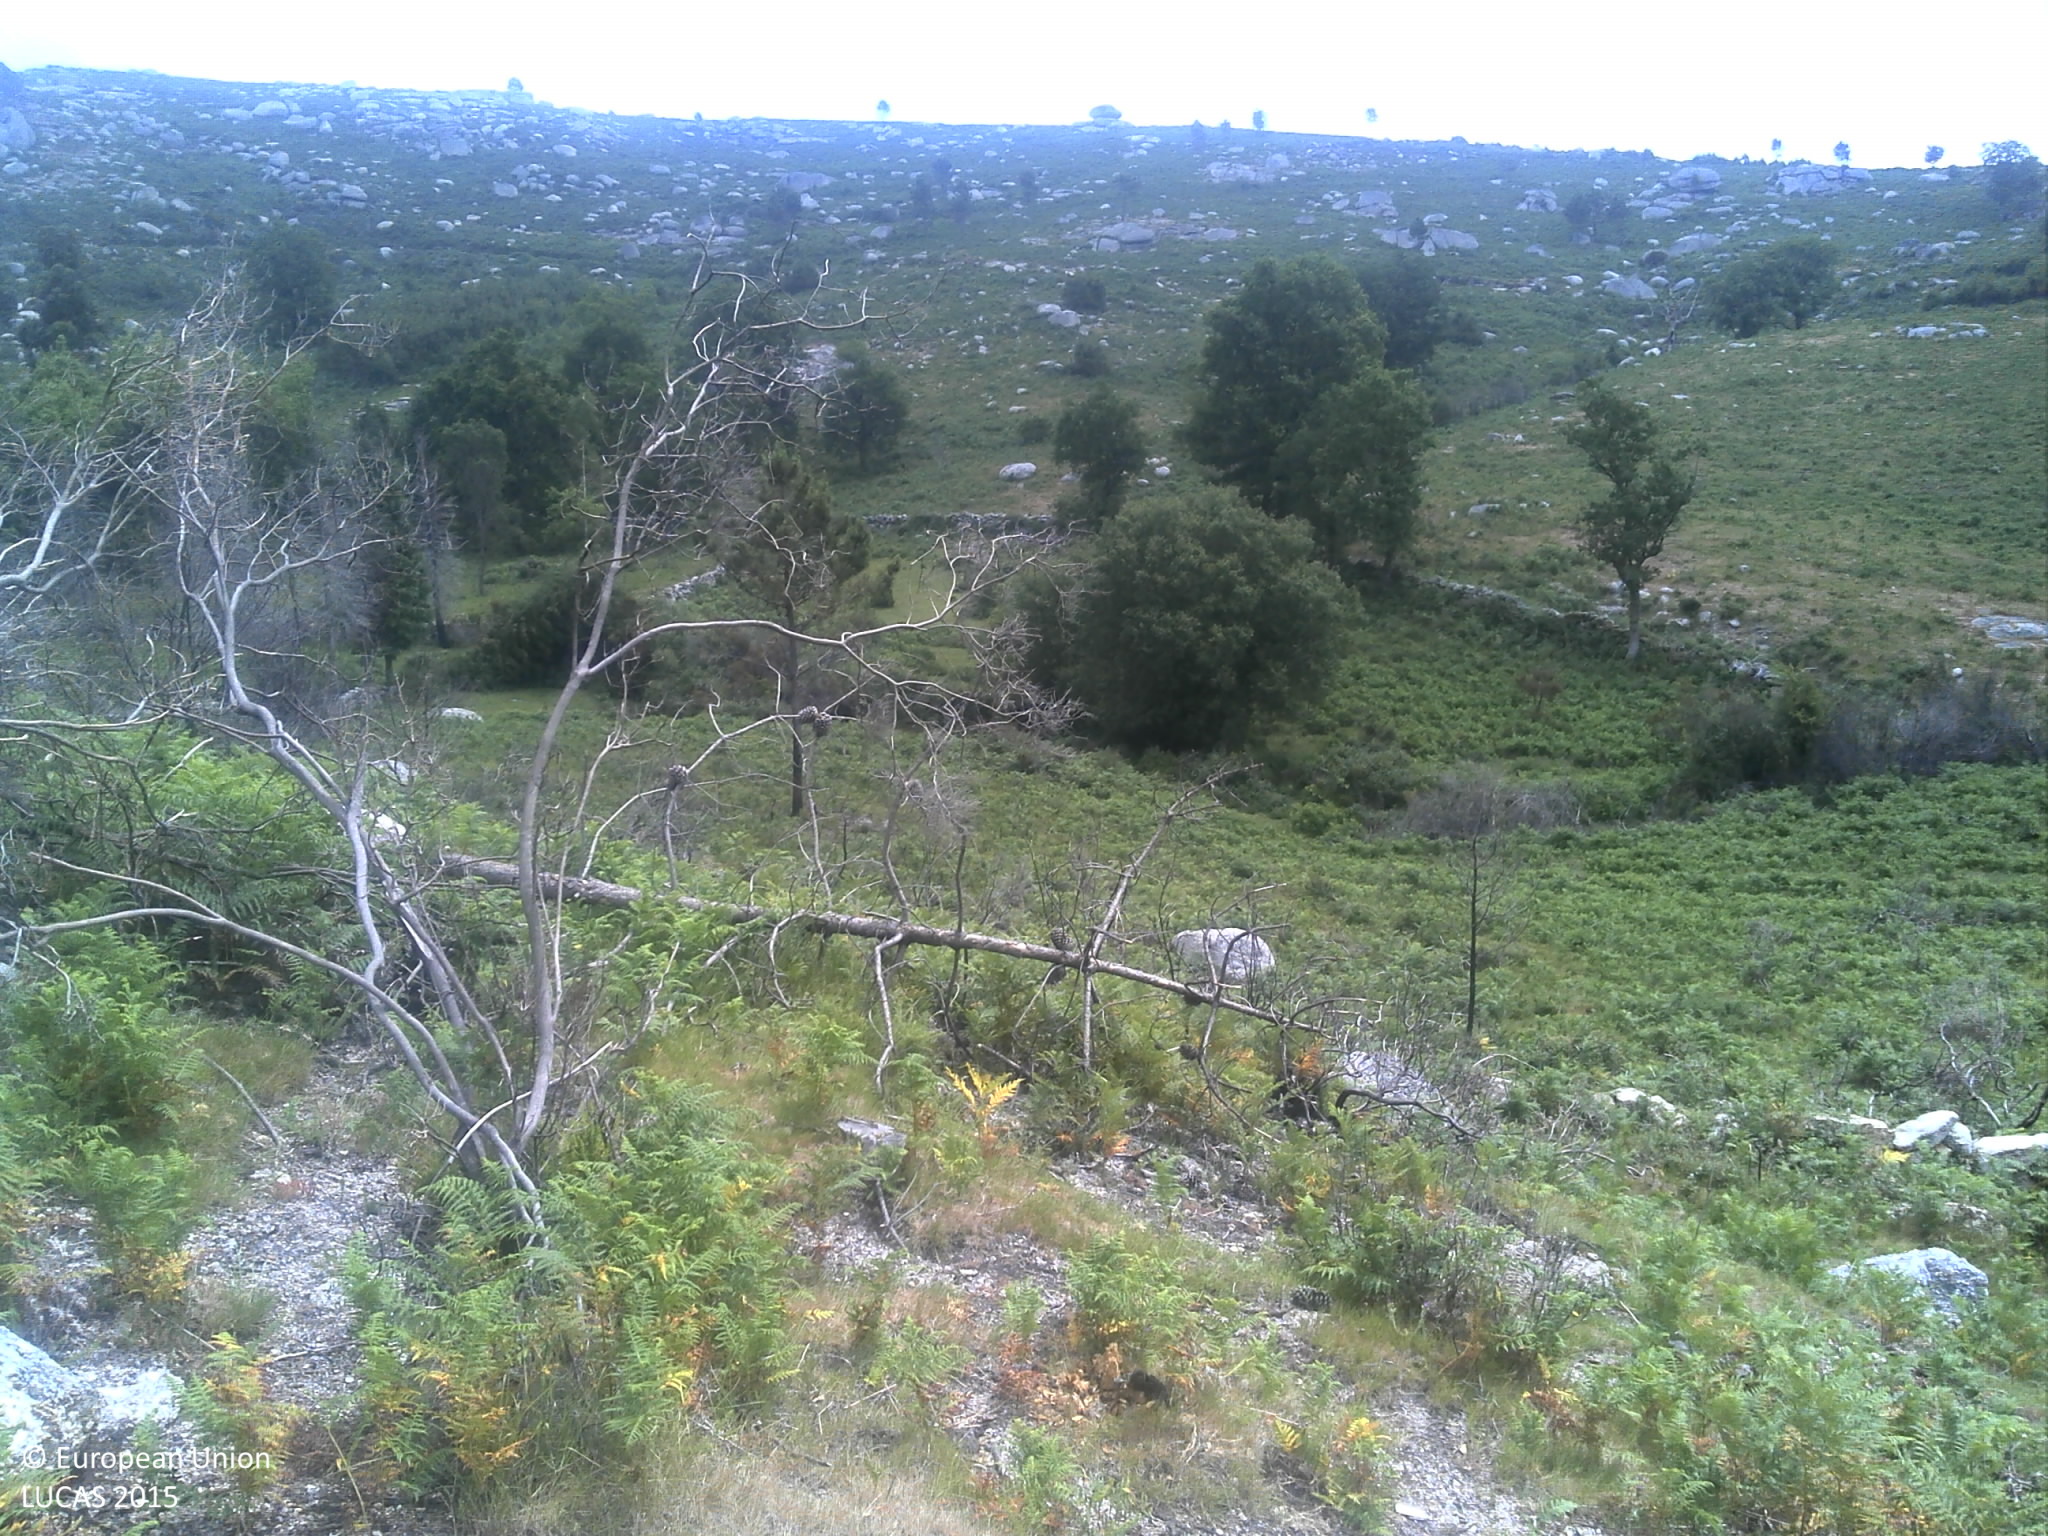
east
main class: Shrubland
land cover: Shrubland without tree cover
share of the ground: 50 - 75 %
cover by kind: shrubs 70 %, consolidated bare surface 20 %, unconsolidated bare surface 10 %
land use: Agriculture (excluding fallow land and kitchen gardens)
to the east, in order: Shrubland without tree cover; Rocks and stones; Shrubland without tree cover; Dry stone walls; Grassland without tree/shrub cover; Shrubland without tree cover; Rivers and streams; Abandoned hedges; Grassland without tree/shrub cover; Shrubland without tree cover; Dry stone walls; Single bushes/trees; Rocks and stones; Shrubland without tree cover; Rocks and stones; Shrubland with sparse tree cover; Rocks and stones
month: June
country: PT
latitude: 41.6846
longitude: -8.2309
